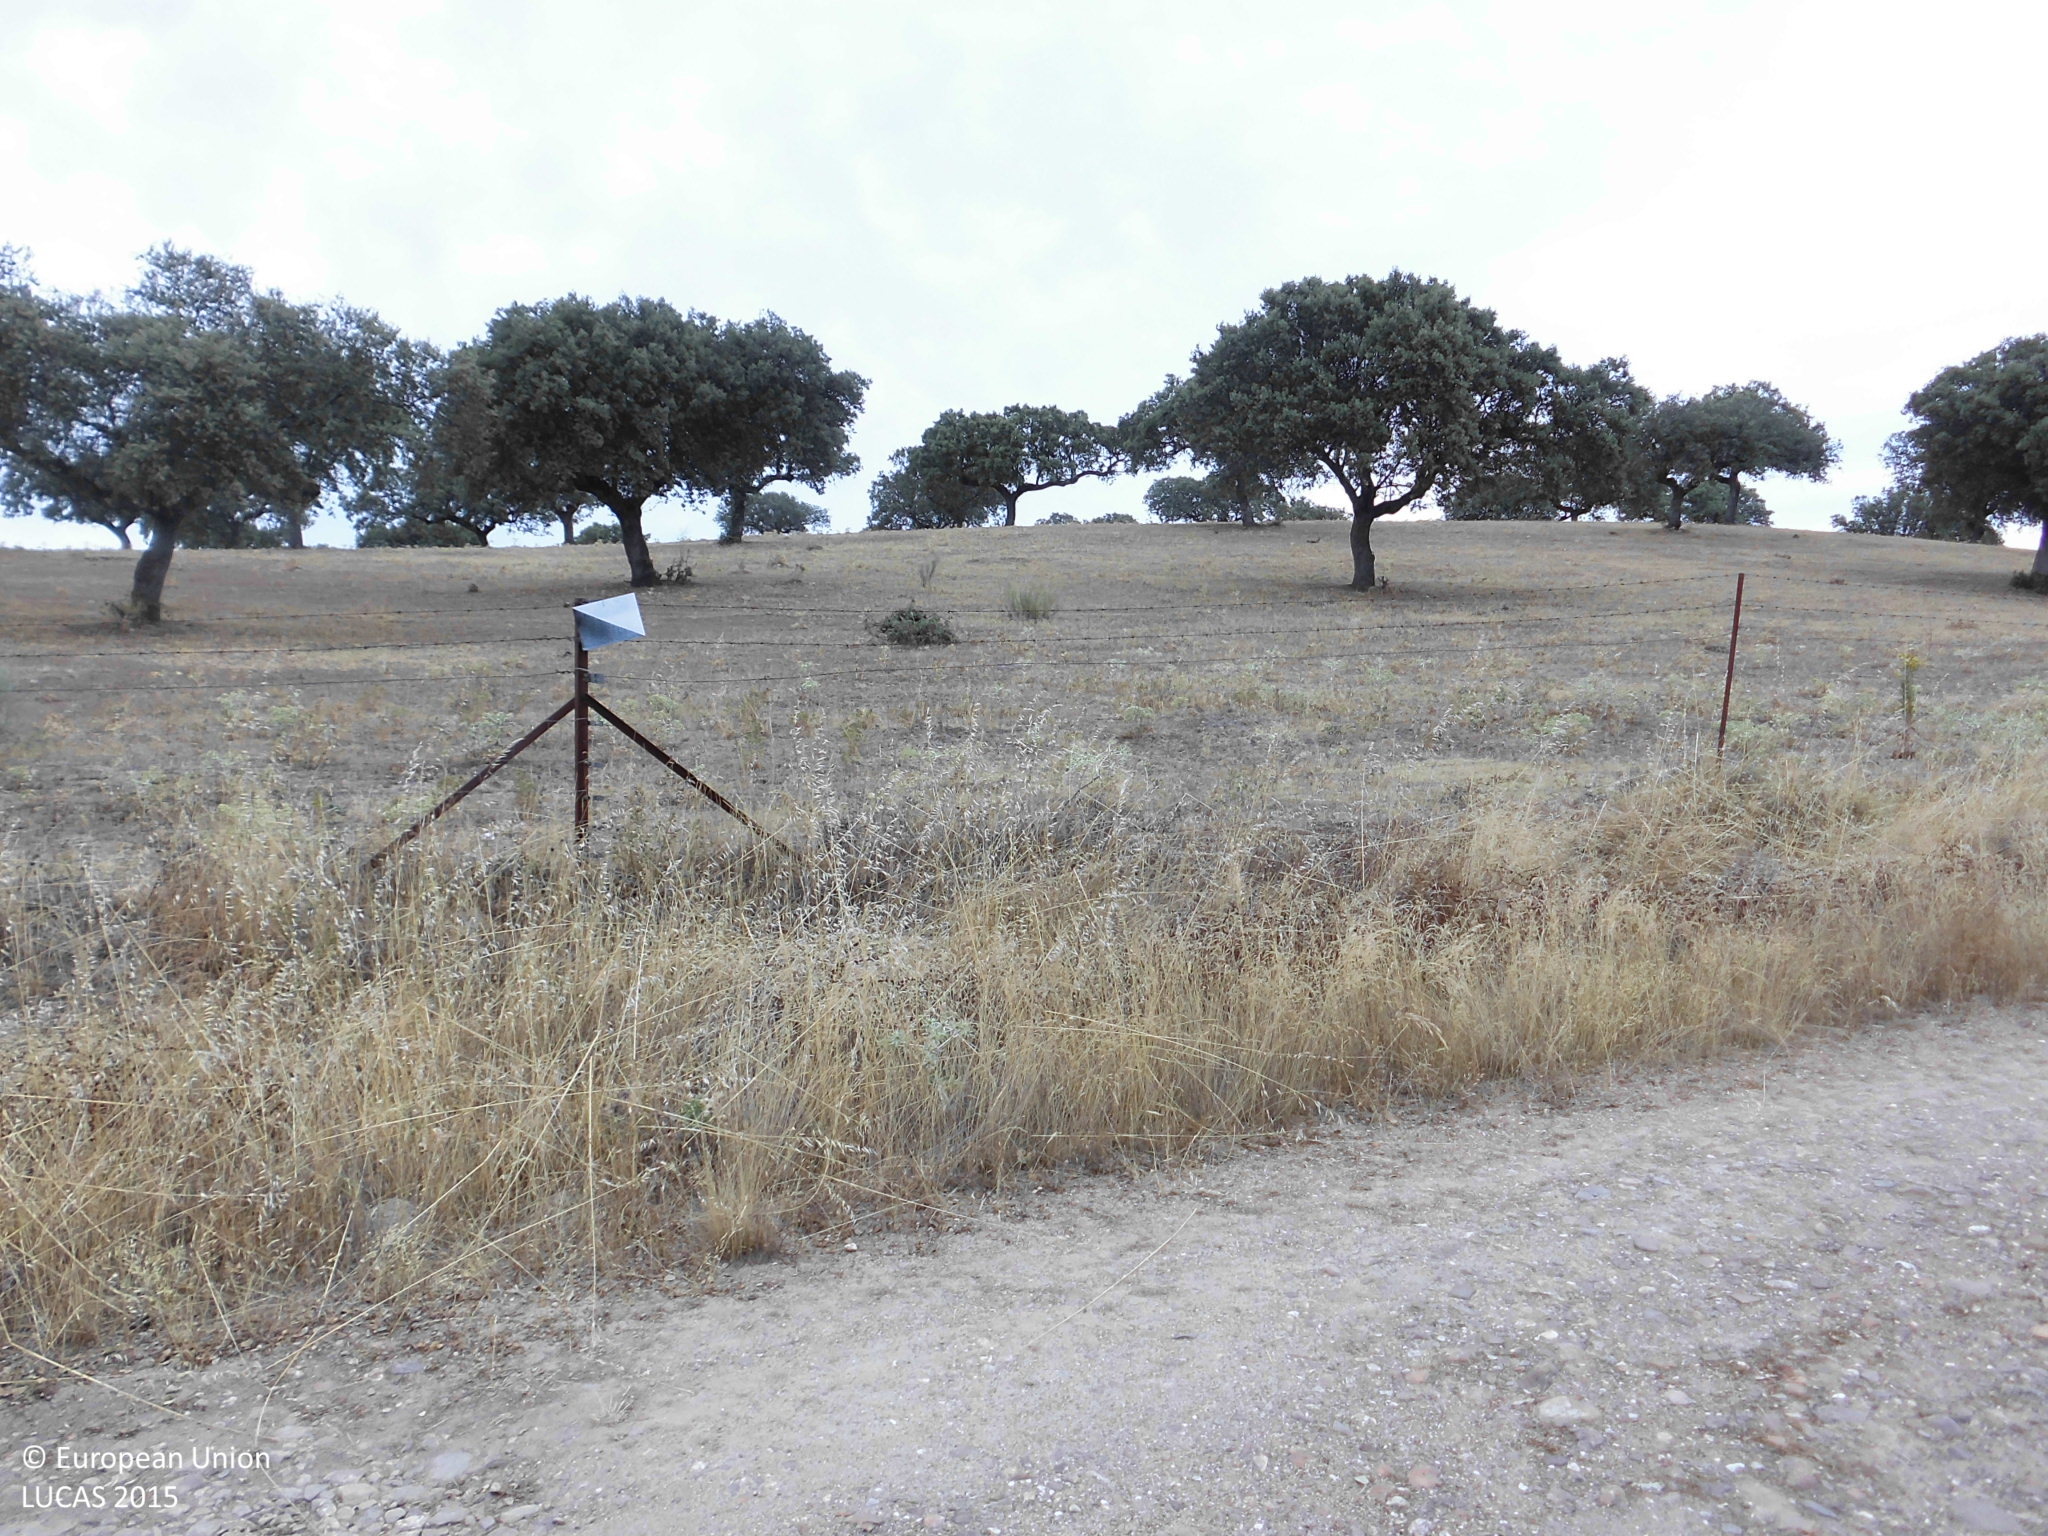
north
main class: Woodland
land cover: Broadleaved woodland
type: broadleaved evergreen forest
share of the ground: 25 - 50 %
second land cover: Grassland without tree/shrub cover
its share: > 75 %
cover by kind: herbaceous plants 55 %, broadleaved forest trees 45 %
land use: Forestry
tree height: > 5 m
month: July
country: ES
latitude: 39.8464
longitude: -6.5450
